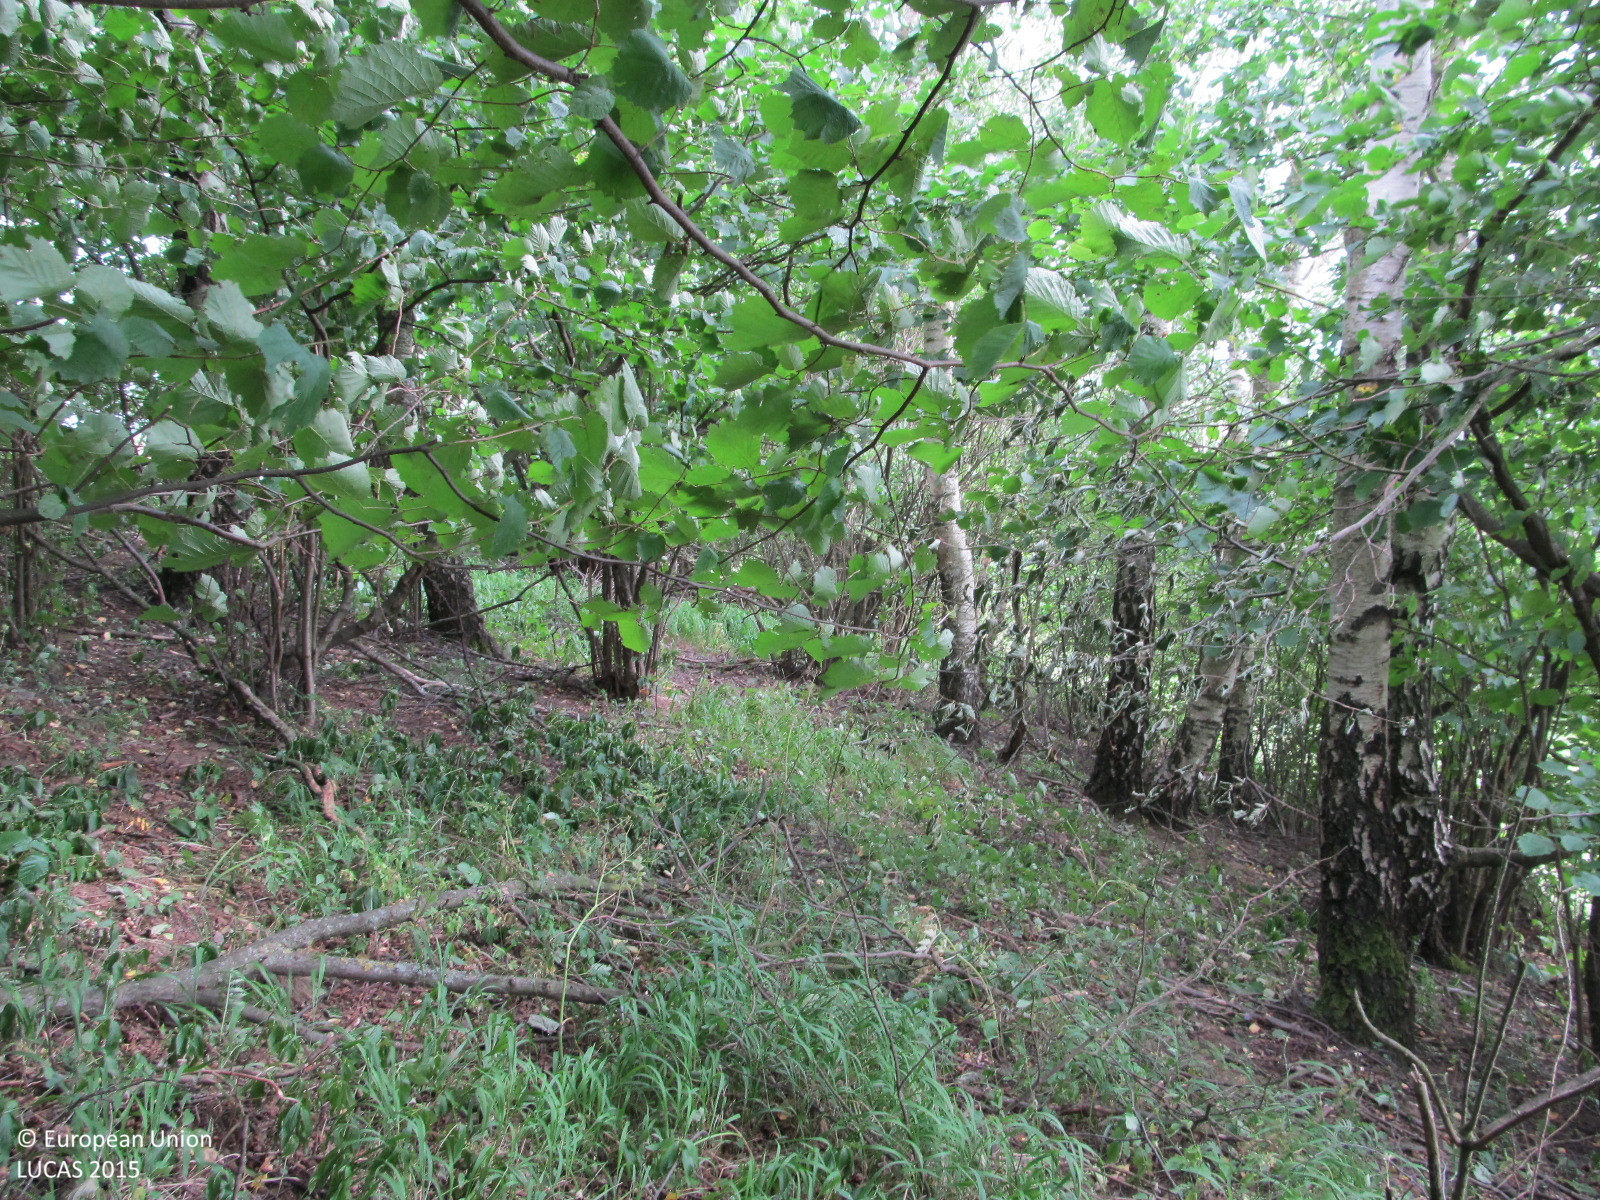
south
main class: Woodland
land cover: Broadleaved woodland
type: non-riverine alder, birch or aspen forest
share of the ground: > 75 %
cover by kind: broadleaved forest trees 75 %, herbaceous plants 15 %, shrubs 5 %, unconsolidated bare surface 5 %
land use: Forestry
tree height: < 5 m
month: July
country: AT
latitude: 48.4328
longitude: 15.4223
